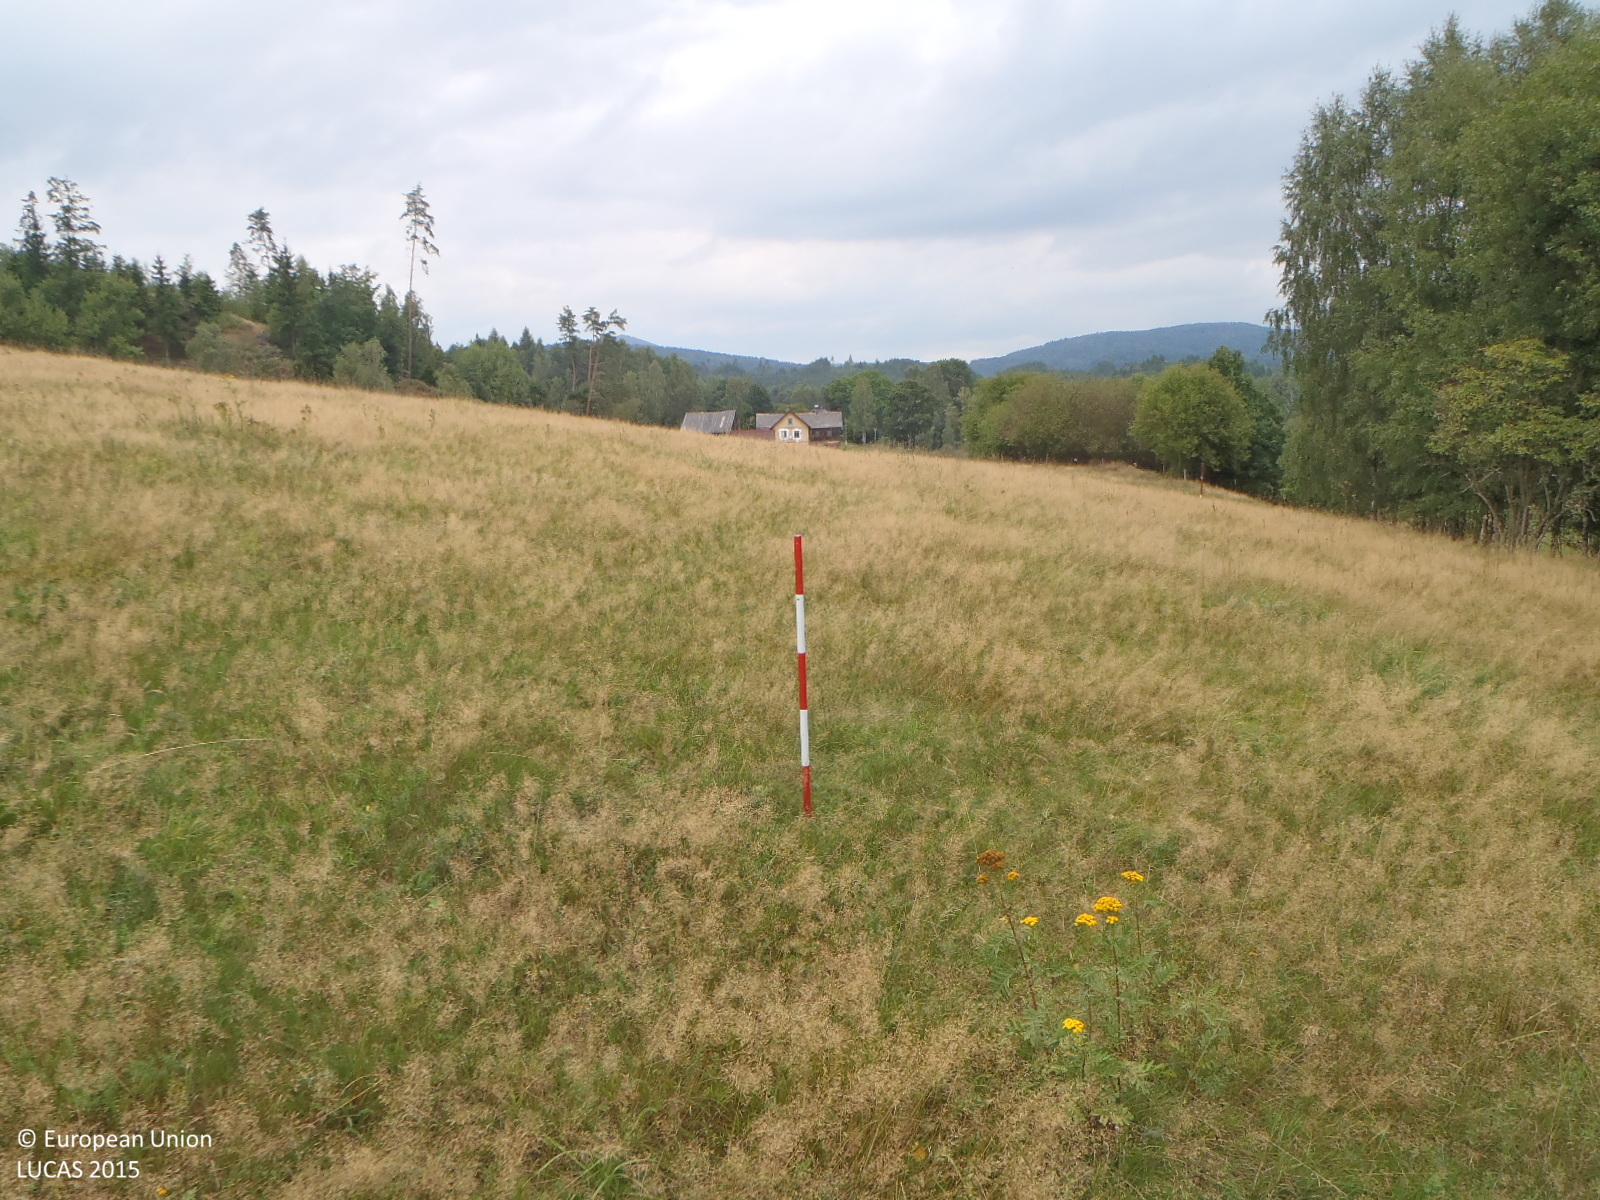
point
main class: Grassland
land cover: Grassland without tree/shrub cover
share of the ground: > 75 %
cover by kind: herbaceous plants 100 %
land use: Agriculture (excluding fallow land and kitchen gardens)
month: August
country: CZ
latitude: 50.7911
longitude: 14.6693
